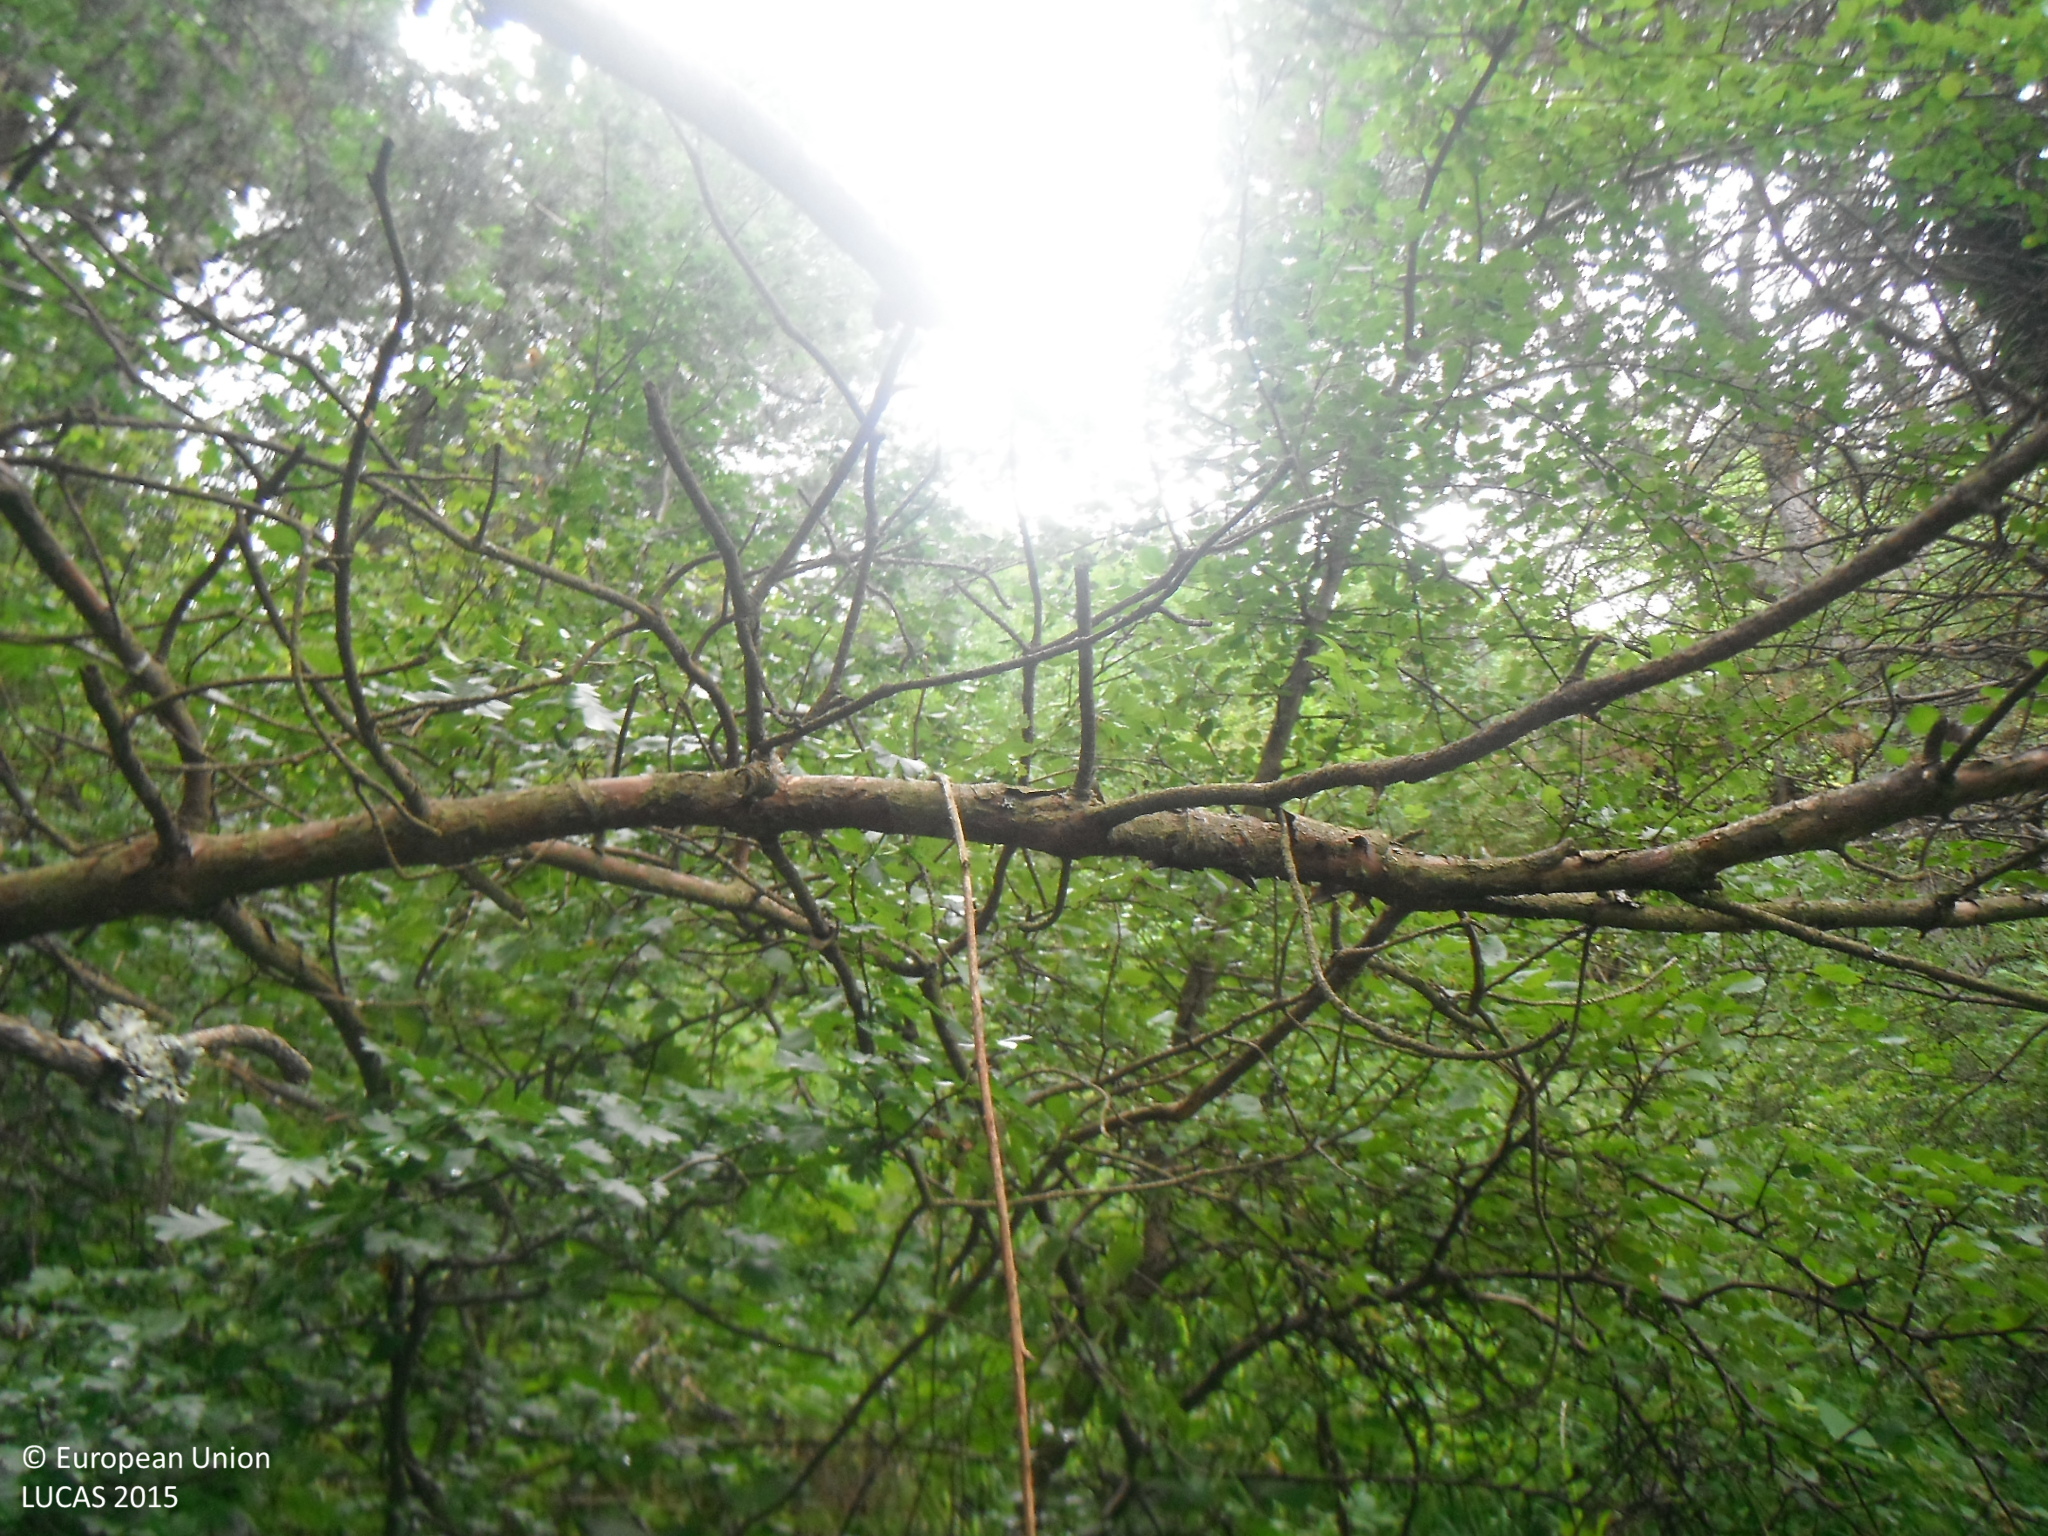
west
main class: Woodland
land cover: Pine dominated coniferous woodland
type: alpine coniferous forest
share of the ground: > 75 %
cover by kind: coniferous forest trees 75 %, herbaceous plants 15 %, shrubs 10 %
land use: Forestry
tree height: > 5 m
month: July
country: SK
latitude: 49.2403
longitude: 18.4097
